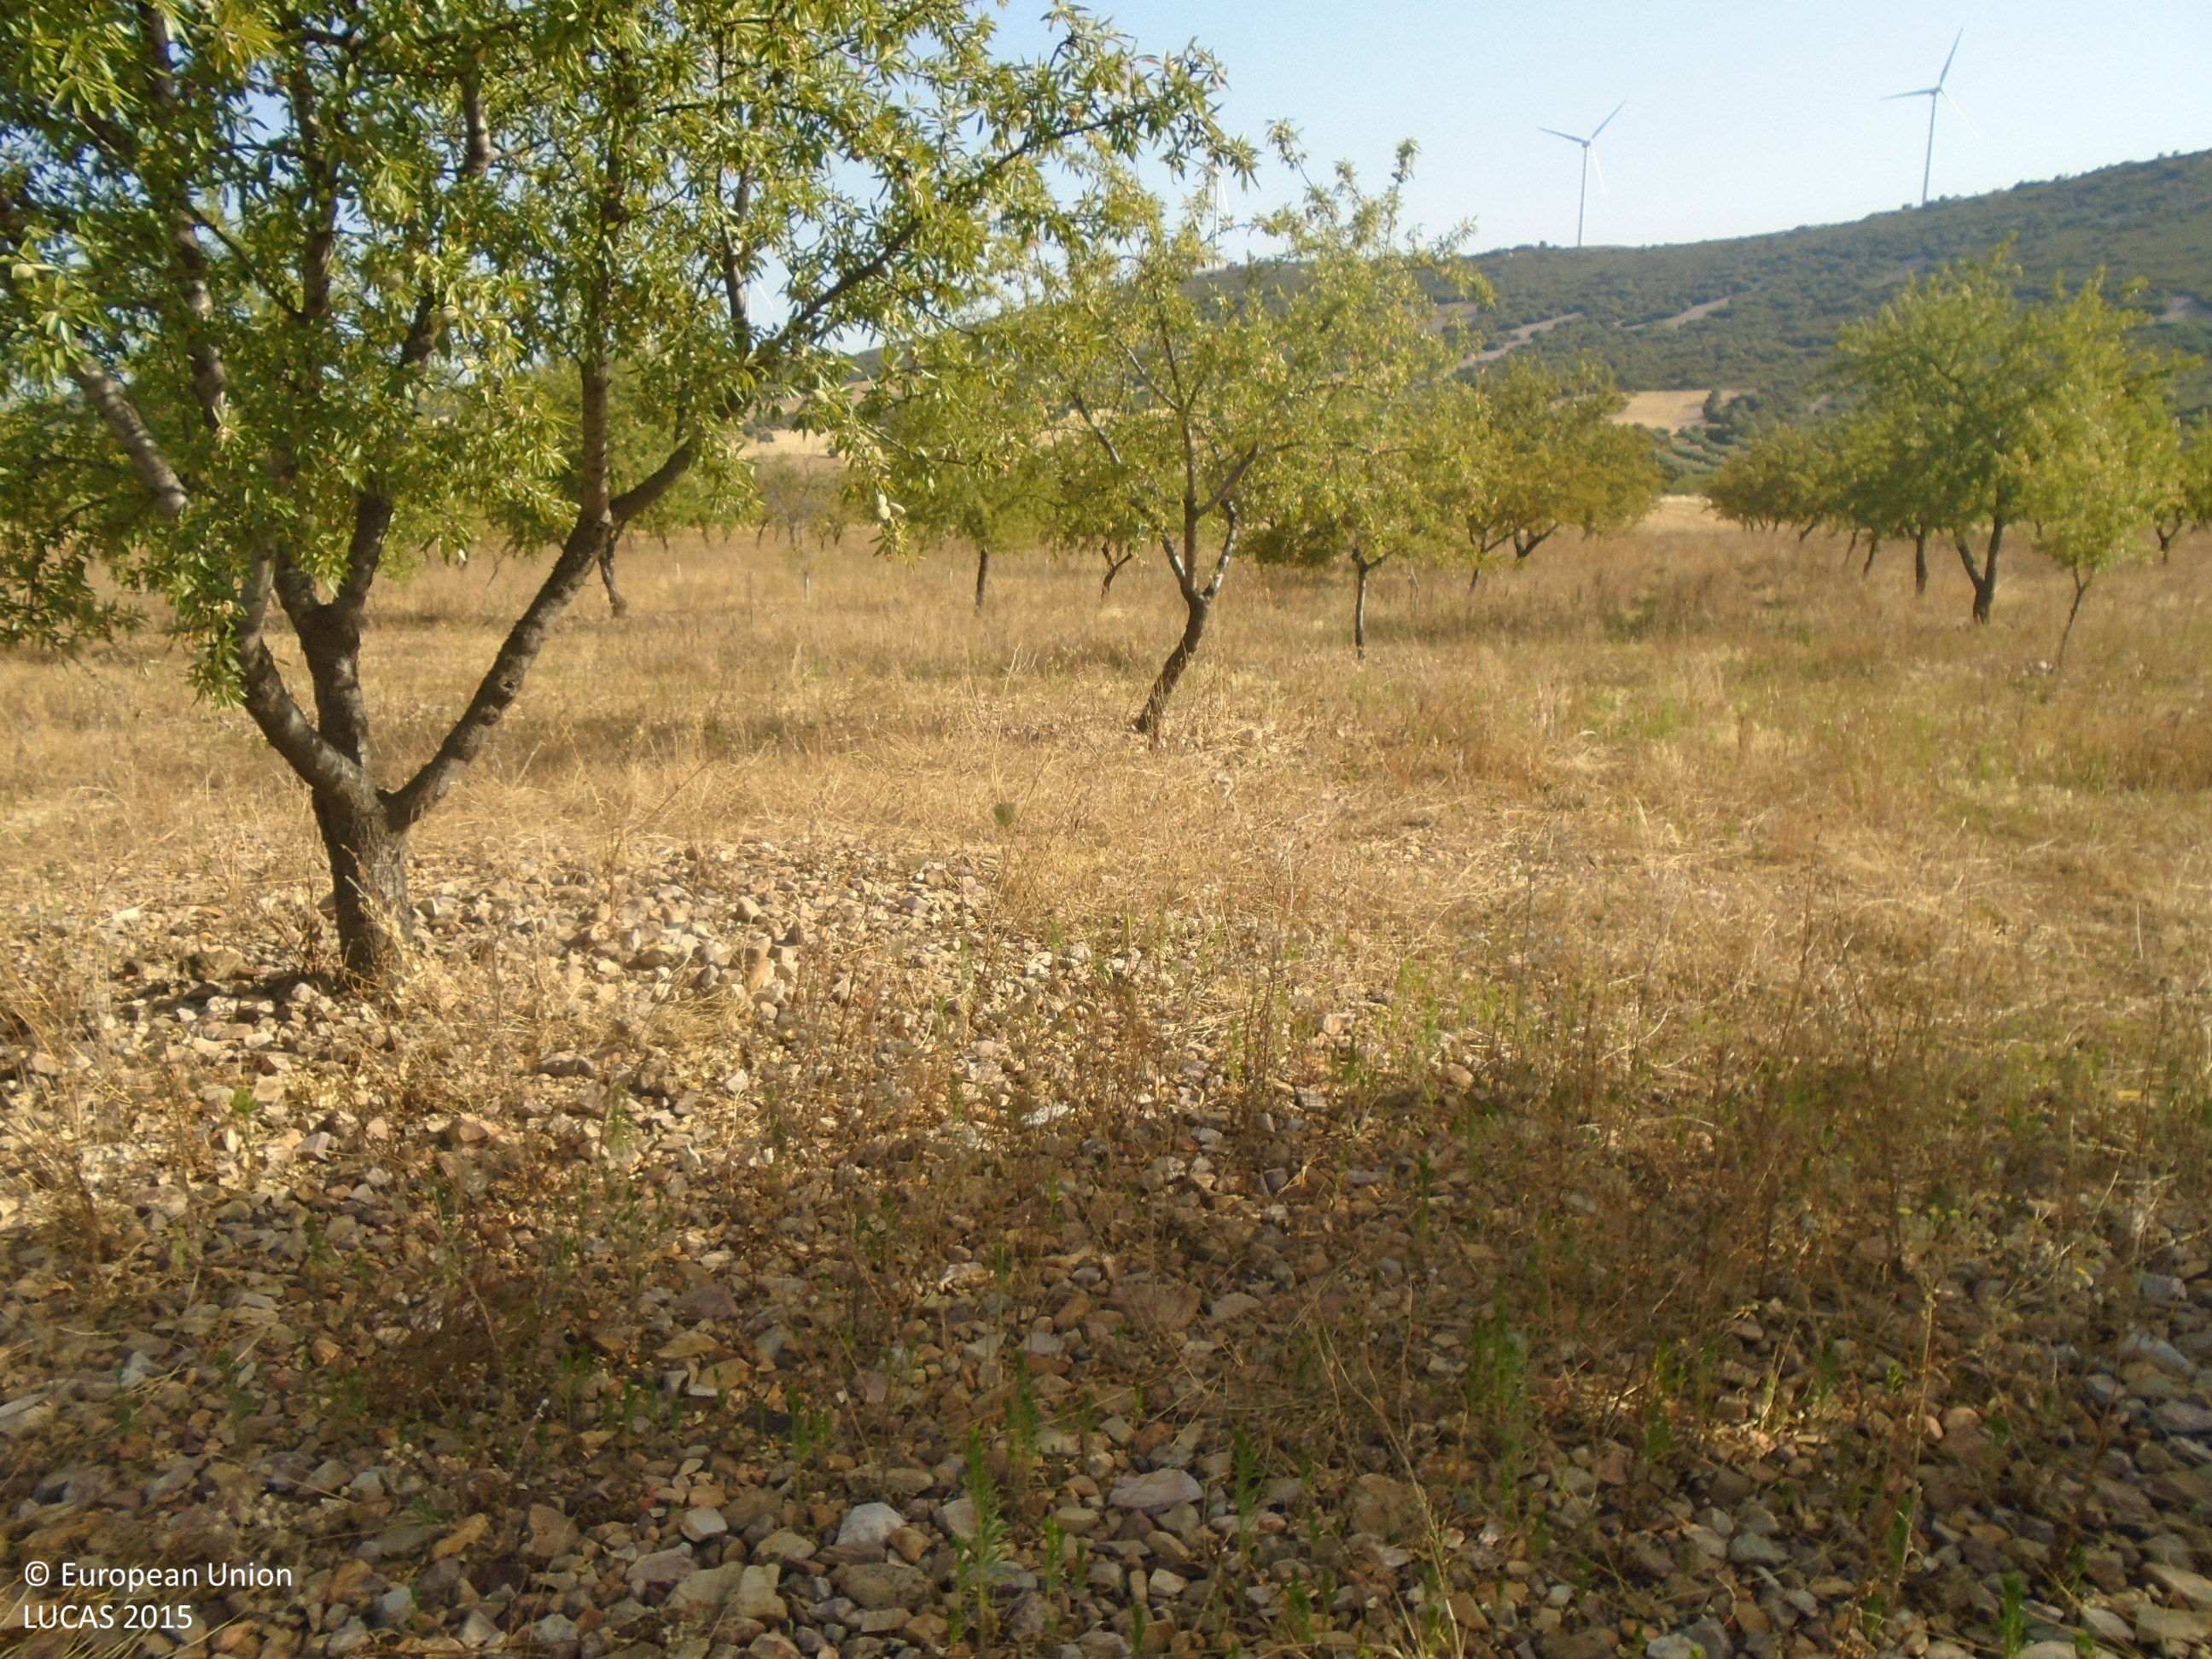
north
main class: Cropland
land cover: Nuts trees
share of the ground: 10 - 25 %
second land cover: Spontaneously vegetated surfaces
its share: > 75 %
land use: Agriculture (excluding fallow land and kitchen gardens)
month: July
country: ES
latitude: 39.2428
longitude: -4.1040
